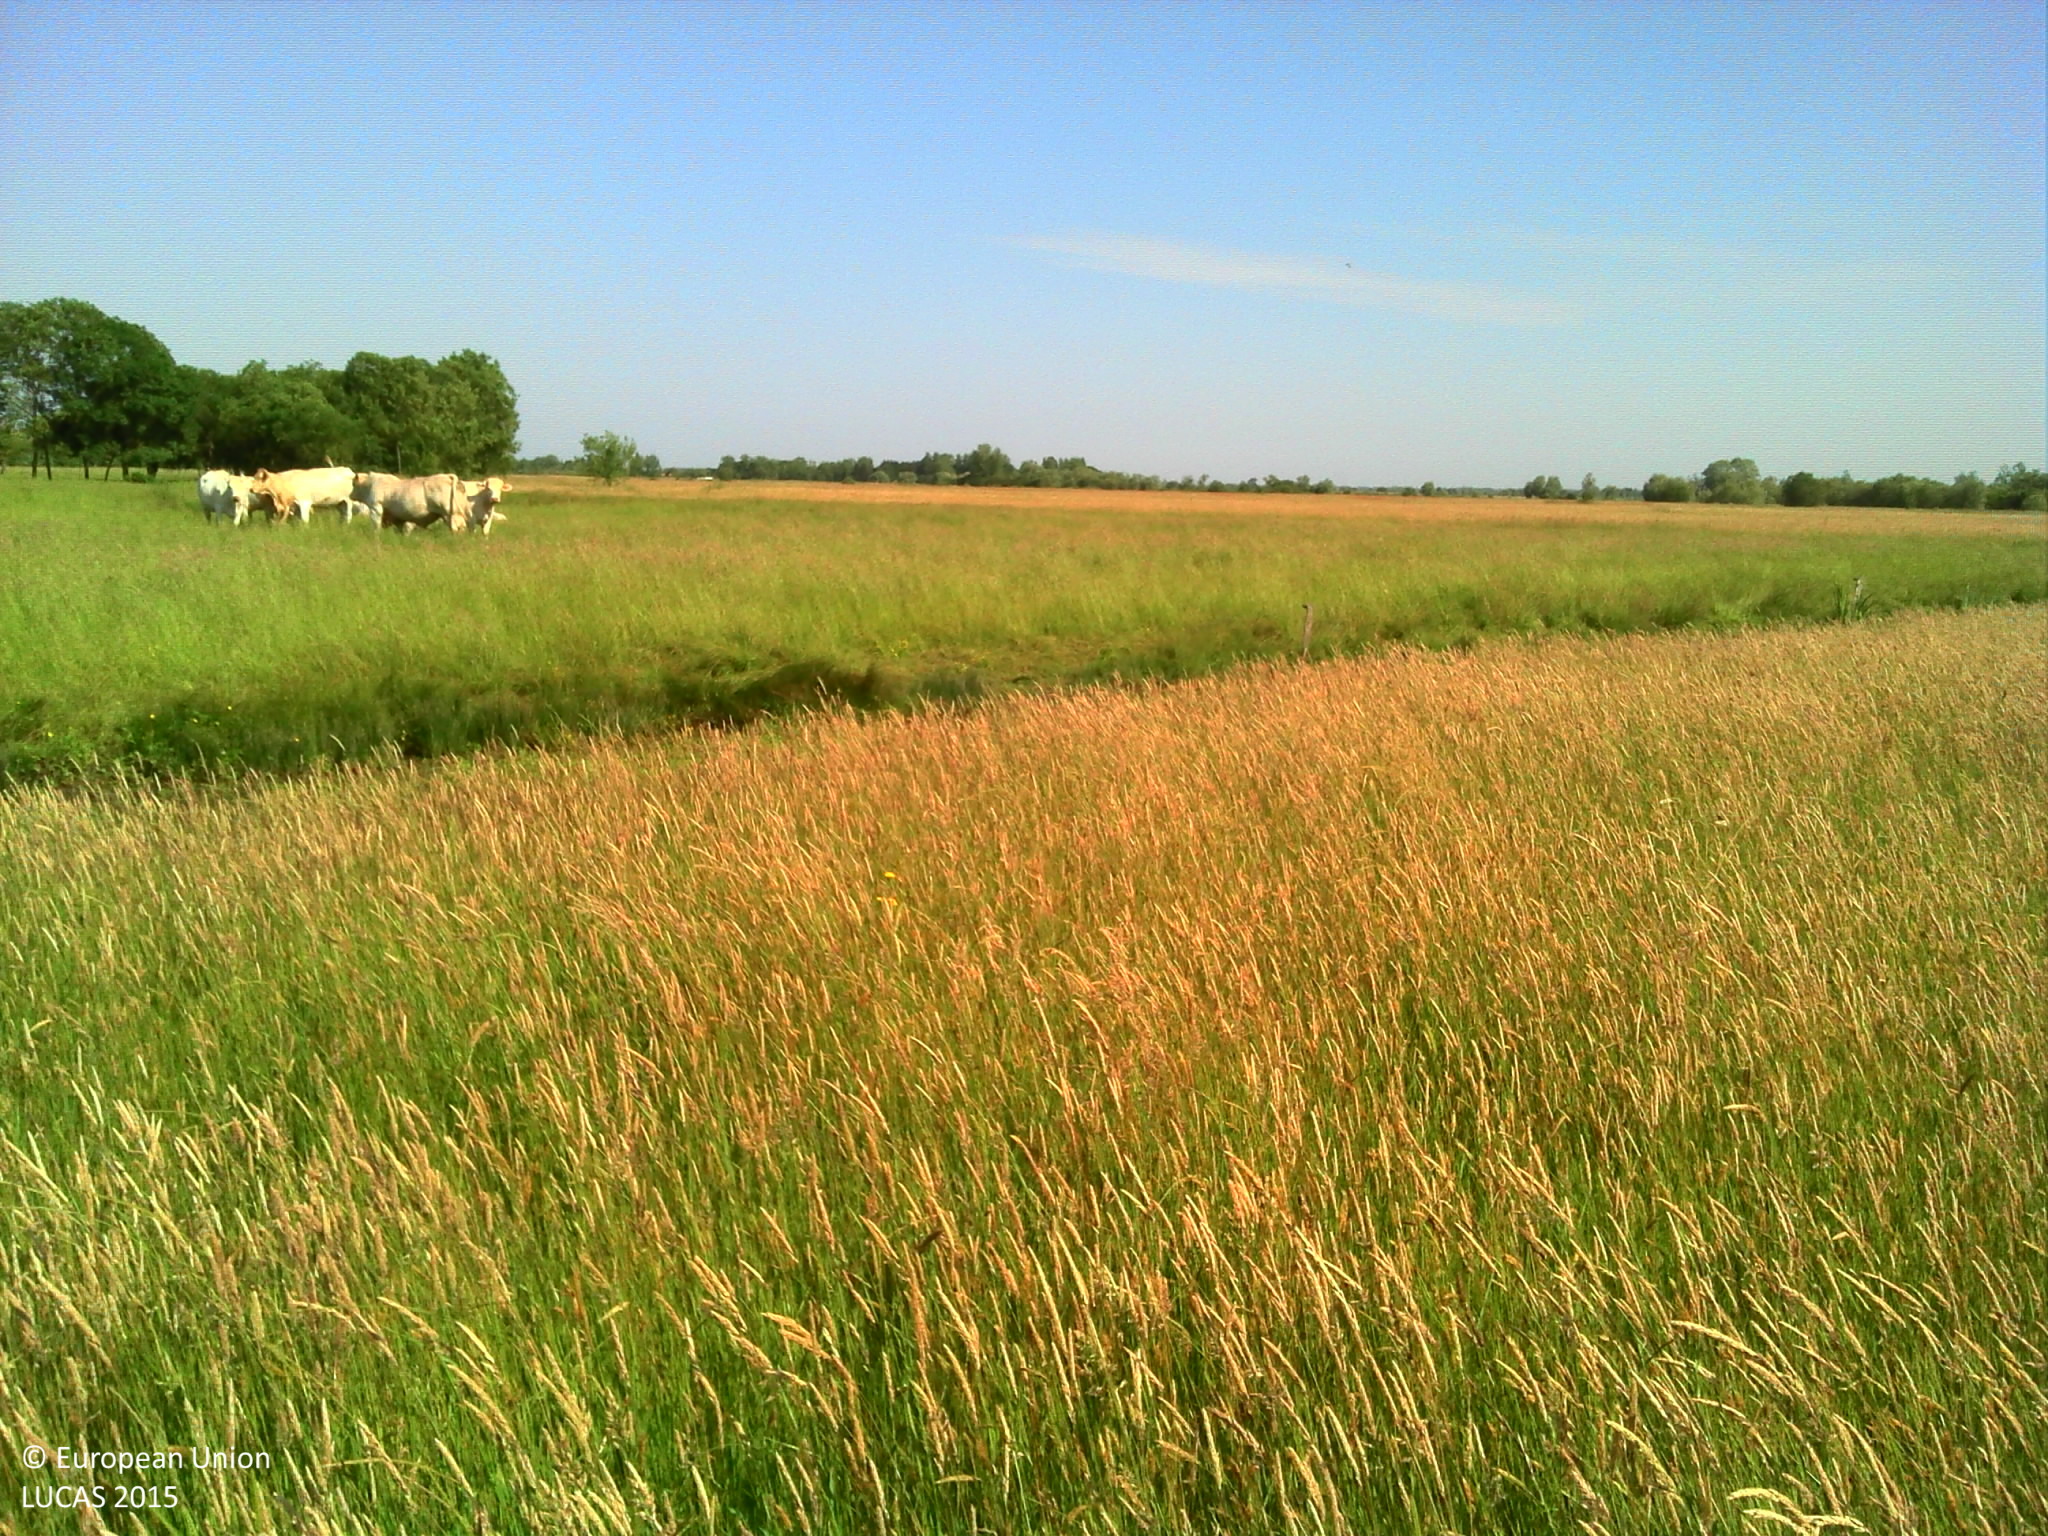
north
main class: Grassland
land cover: Grassland without tree/shrub cover
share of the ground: > 75 %
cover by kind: herbaceous plants 100 %
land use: Agriculture (excluding fallow land and kitchen gardens)
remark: Temporary flooded
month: June
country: FR
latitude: 46.8386
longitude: -1.9909
